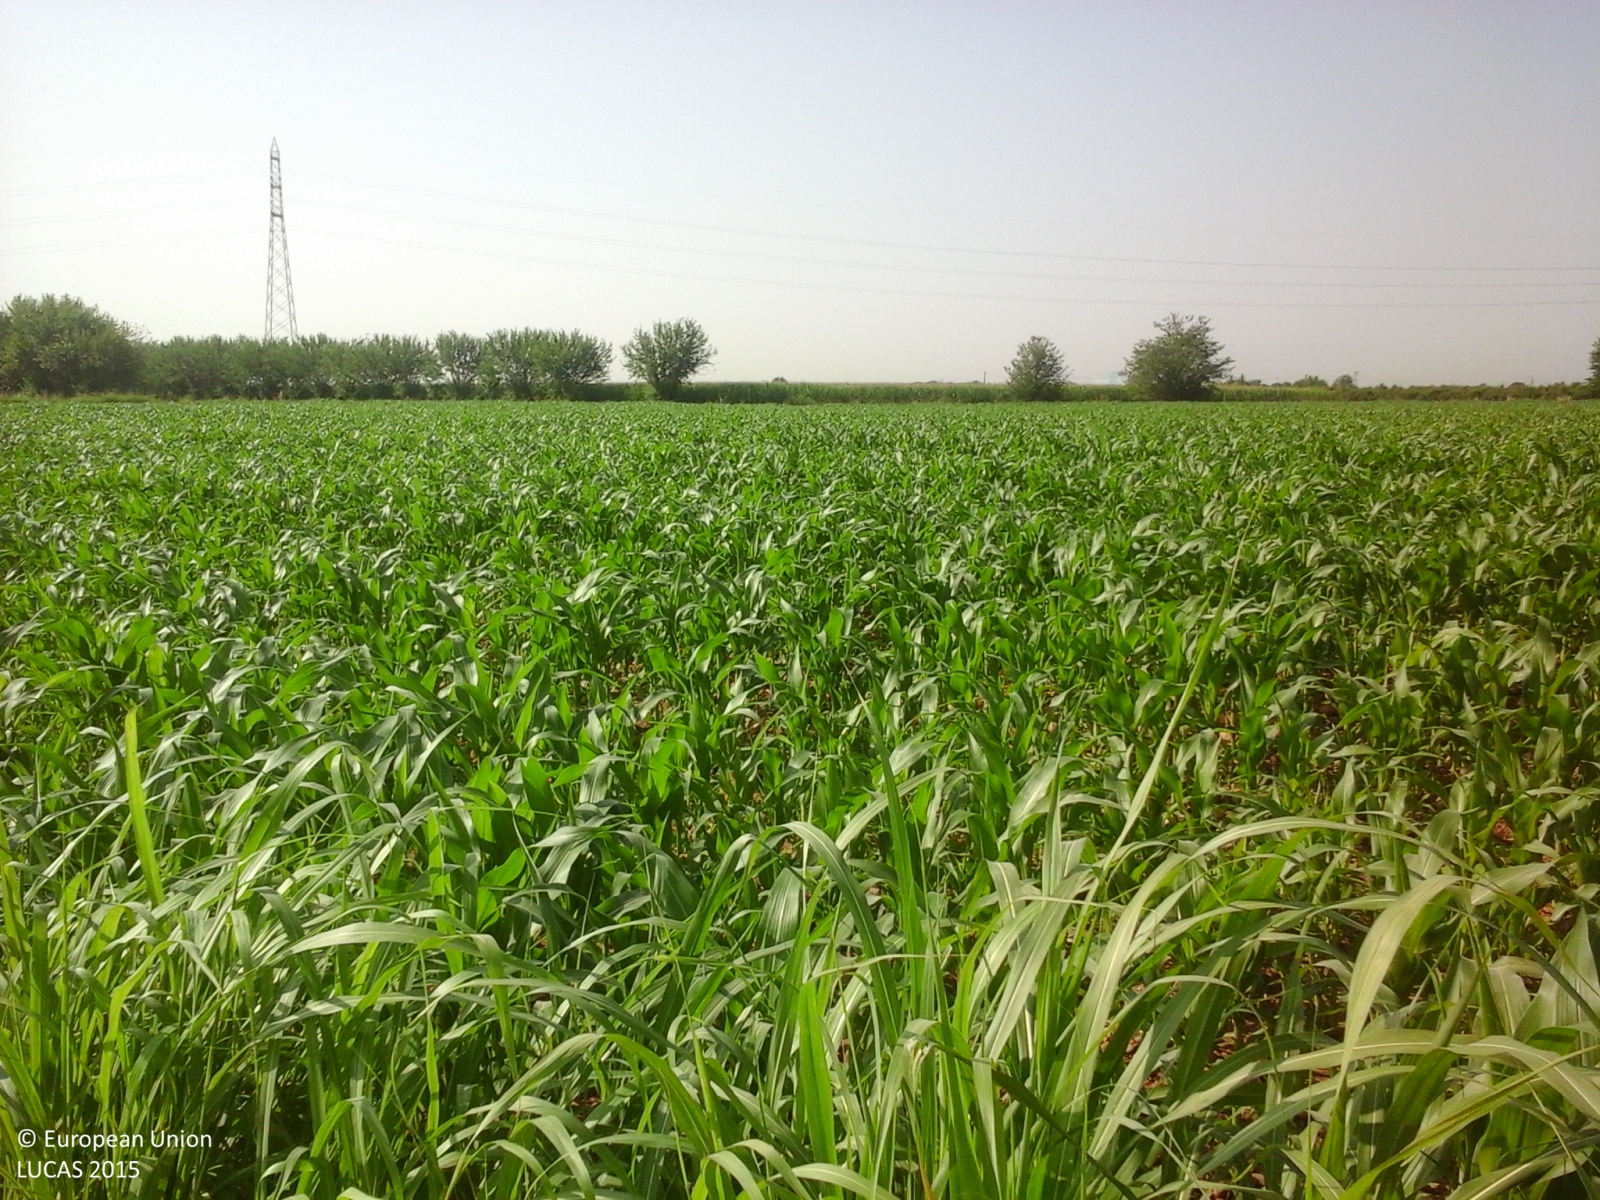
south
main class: Cropland
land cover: Maize
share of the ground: 50 - 75 %
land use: Agriculture (excluding fallow land and kitchen gardens)
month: July
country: IT
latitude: 45.3389
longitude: 10.8280
